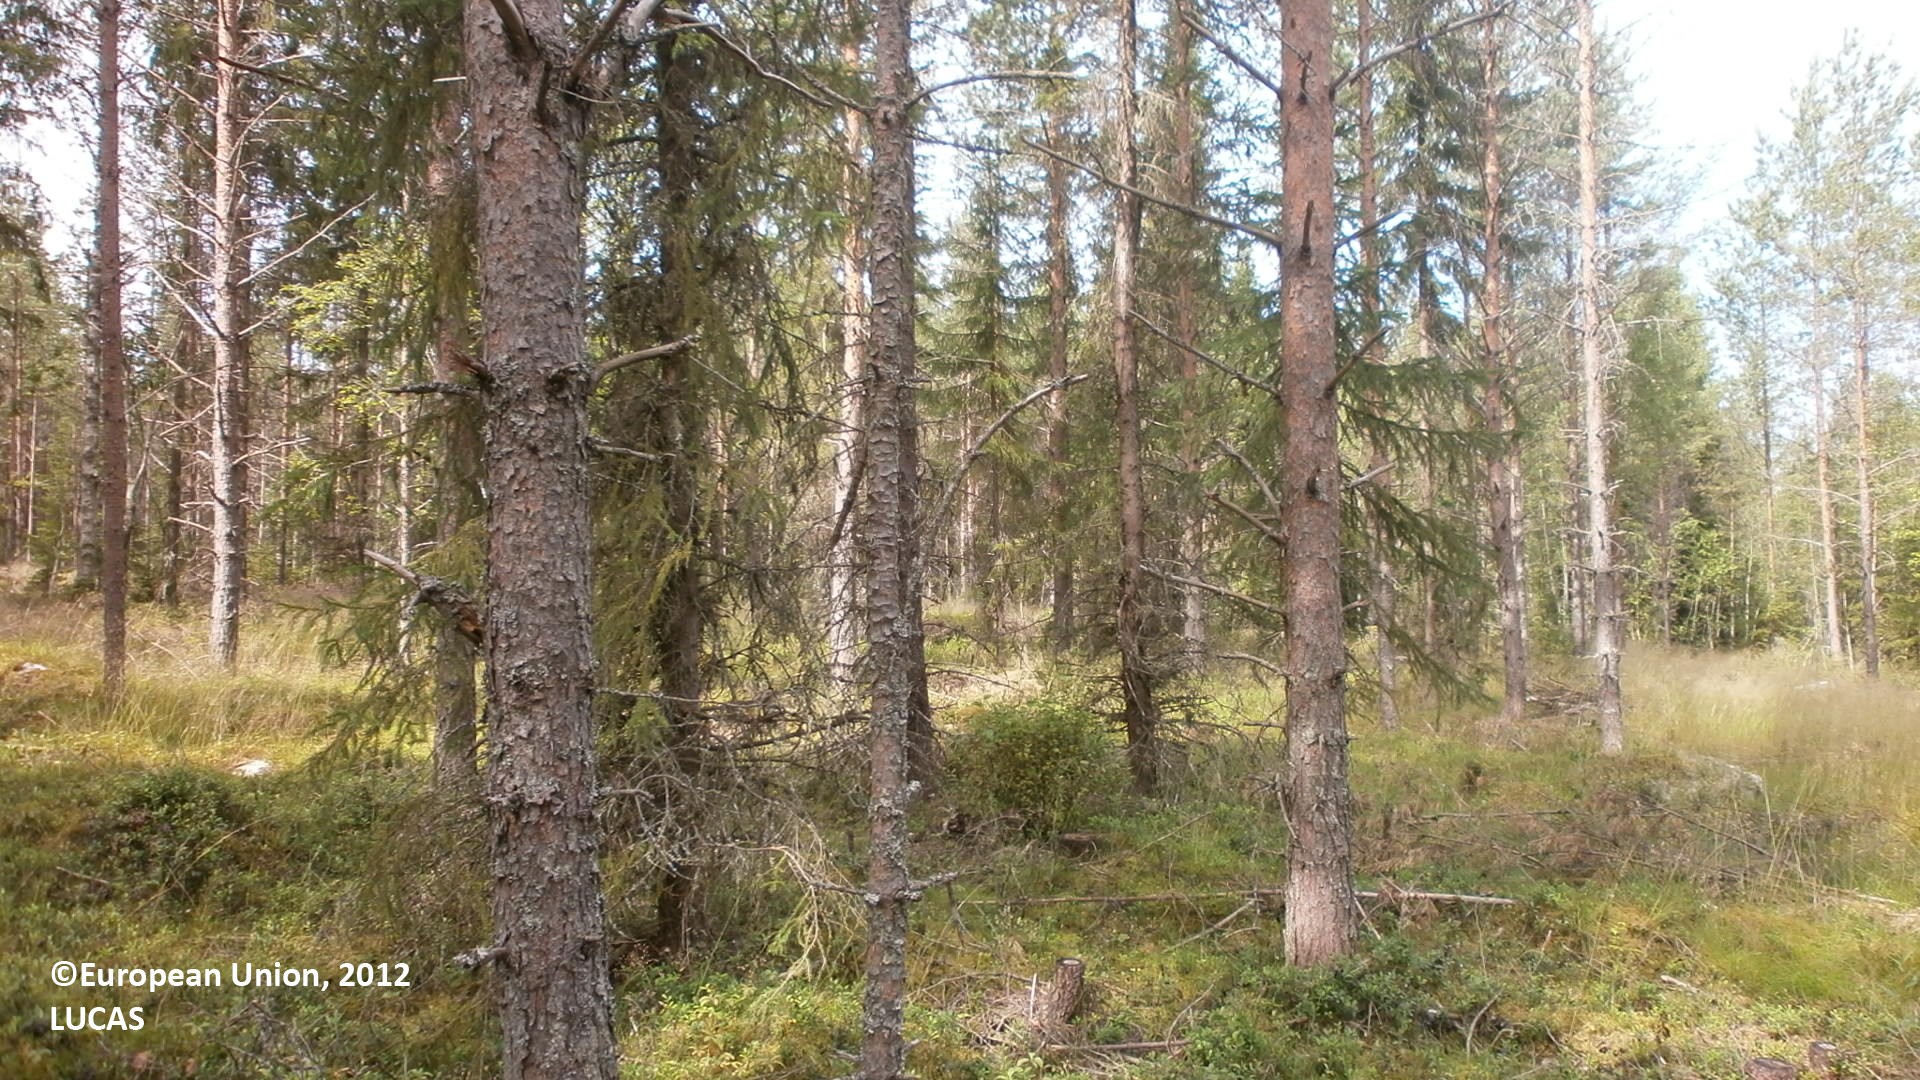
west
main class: Woodland
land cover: Pine dominated coniferous woodland
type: boreal forest
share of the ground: 50 - 75 %
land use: Forestry
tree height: > 5 m
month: July
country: FI
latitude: 64.0592
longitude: 23.8931
